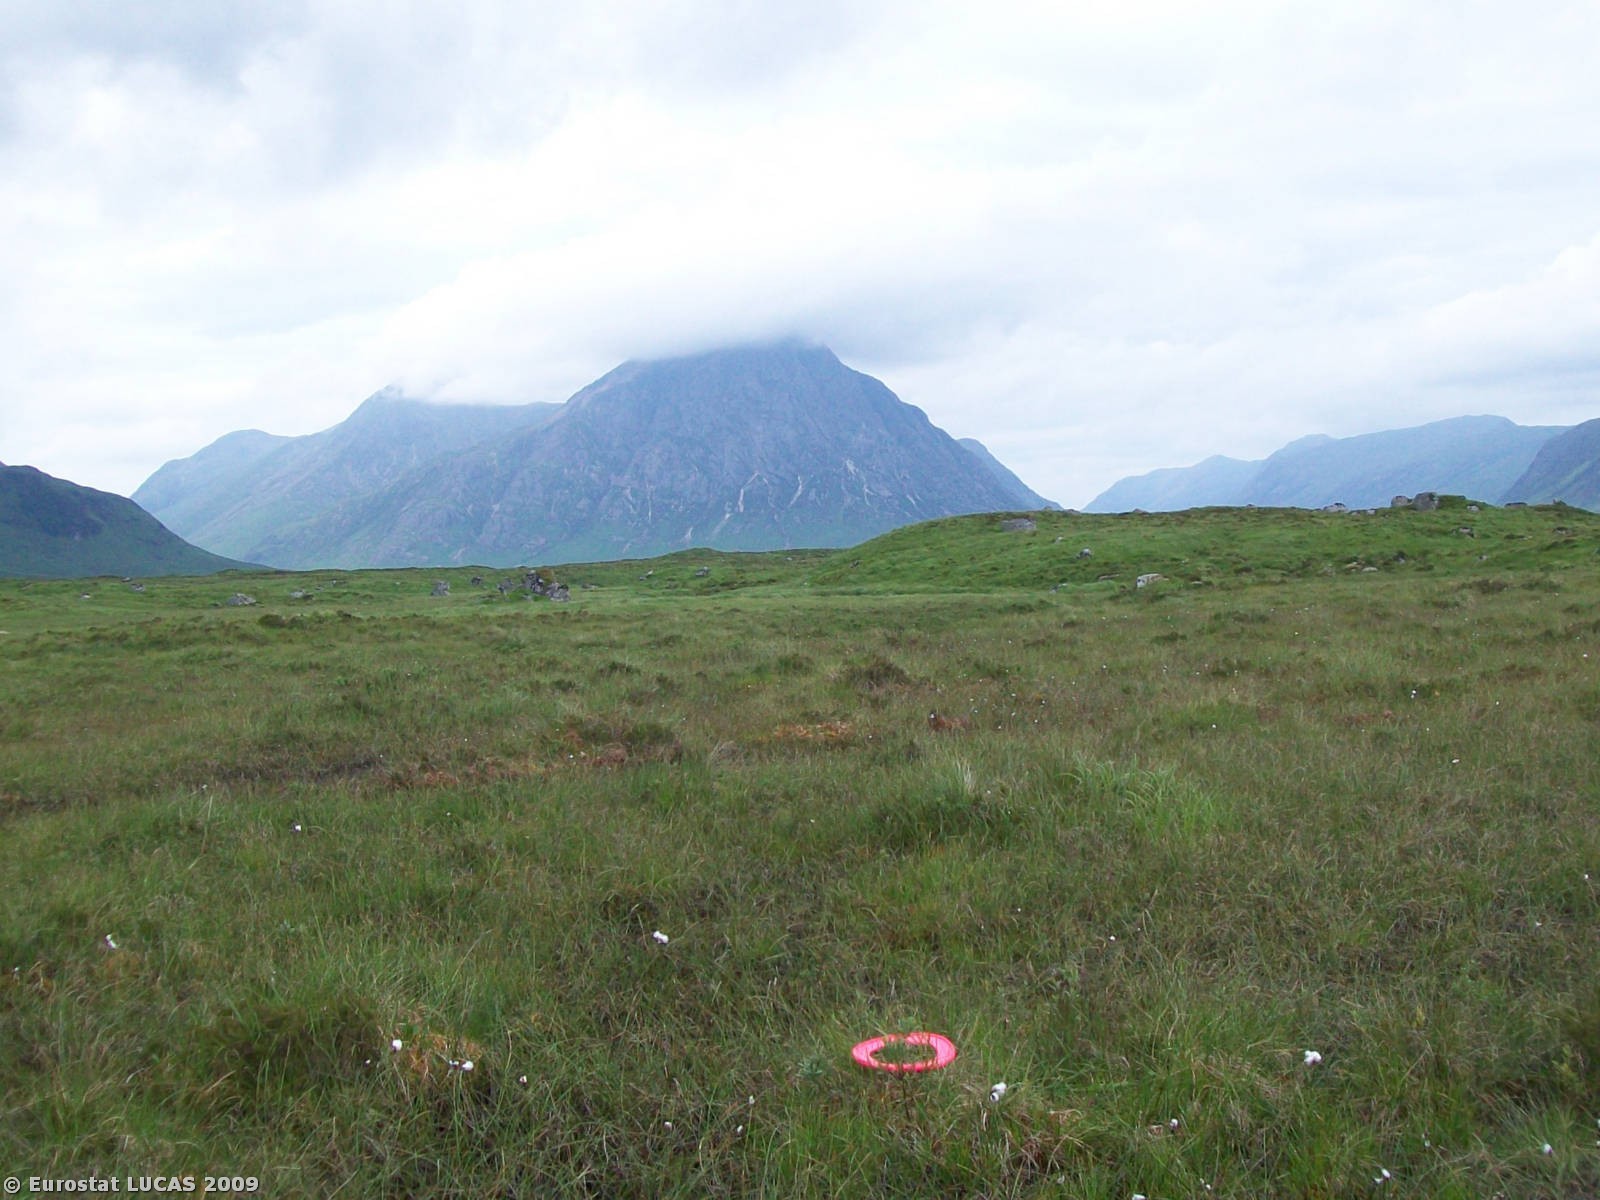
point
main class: Wetlands
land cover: Peatbogs
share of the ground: > 75 %
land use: Nature reserves
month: June
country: GB
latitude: 56.6425
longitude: -4.7943
